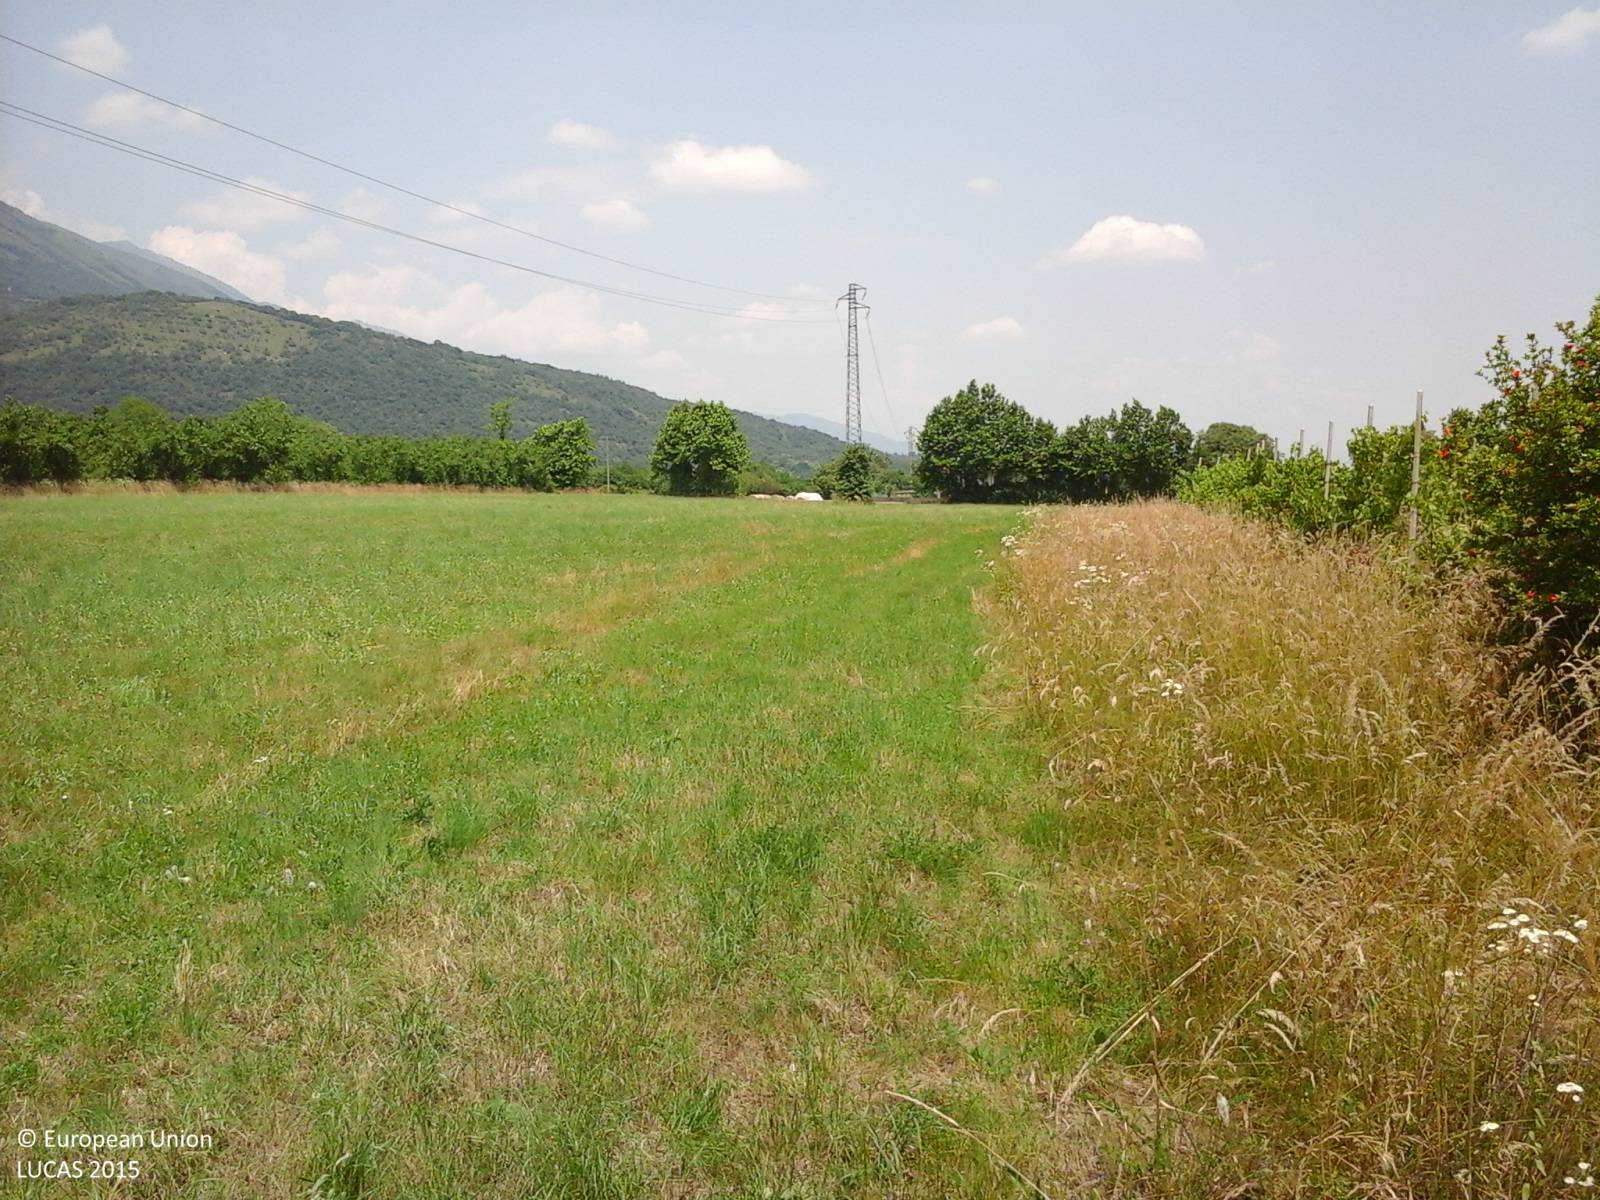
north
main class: Cropland
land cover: Vineyards
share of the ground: > 75 %
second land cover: Grassland without tree/shrub cover
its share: > 75 %
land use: Agriculture (excluding fallow land and kitchen gardens)
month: June
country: IT
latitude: 46.0507
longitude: 12.5429
